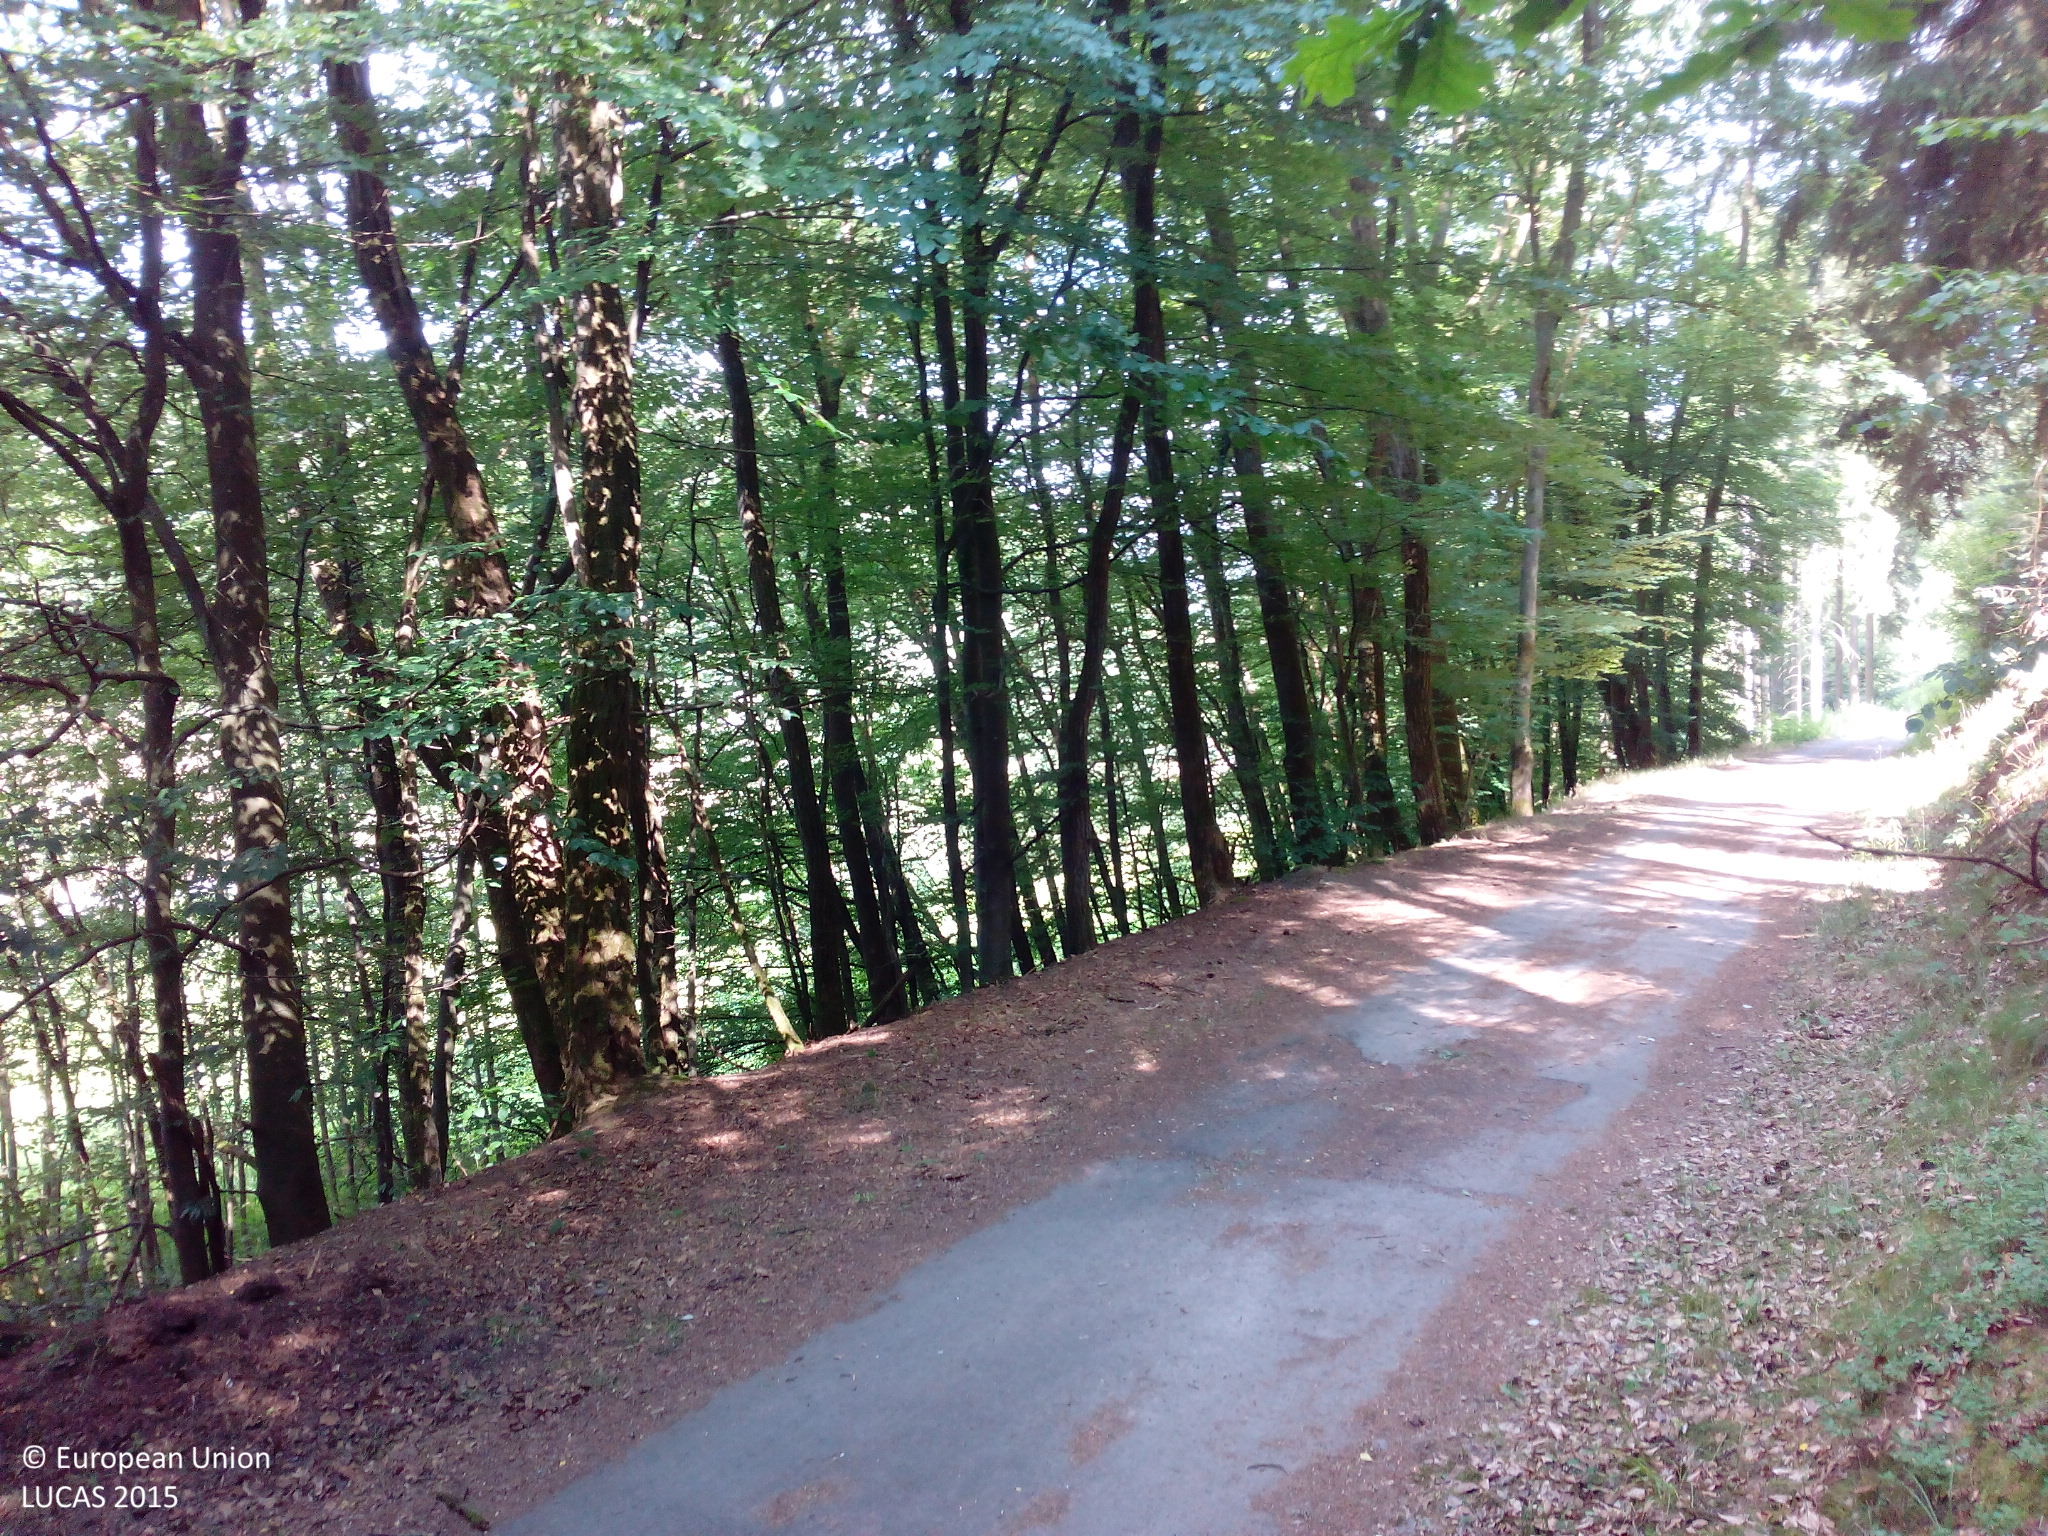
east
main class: Woodland
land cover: Spruce dominated mixed woodland
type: hemiboreal forest and nemoral coniferous forest and mixed broadleaved-coniferous forest
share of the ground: > 75 %
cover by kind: coniferous forest trees 60 %, broadleaved forest trees 20 %, unconsolidated bare surface 10 %, shrubs 5 %, herbaceous plants 5 %
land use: Forestry
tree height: > 5 m
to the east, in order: Spruce dominated mixed woodland; Tracks; Broadleaved woodland; Inland fresh running water; Grassland with sparse tree/shrub cover; Inland fresh running water; Broadleaved woodland; Artificial constructions in urban areas; Spontaneously vegetated surfaces
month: July
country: DE
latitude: 49.1317
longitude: 7.5199
